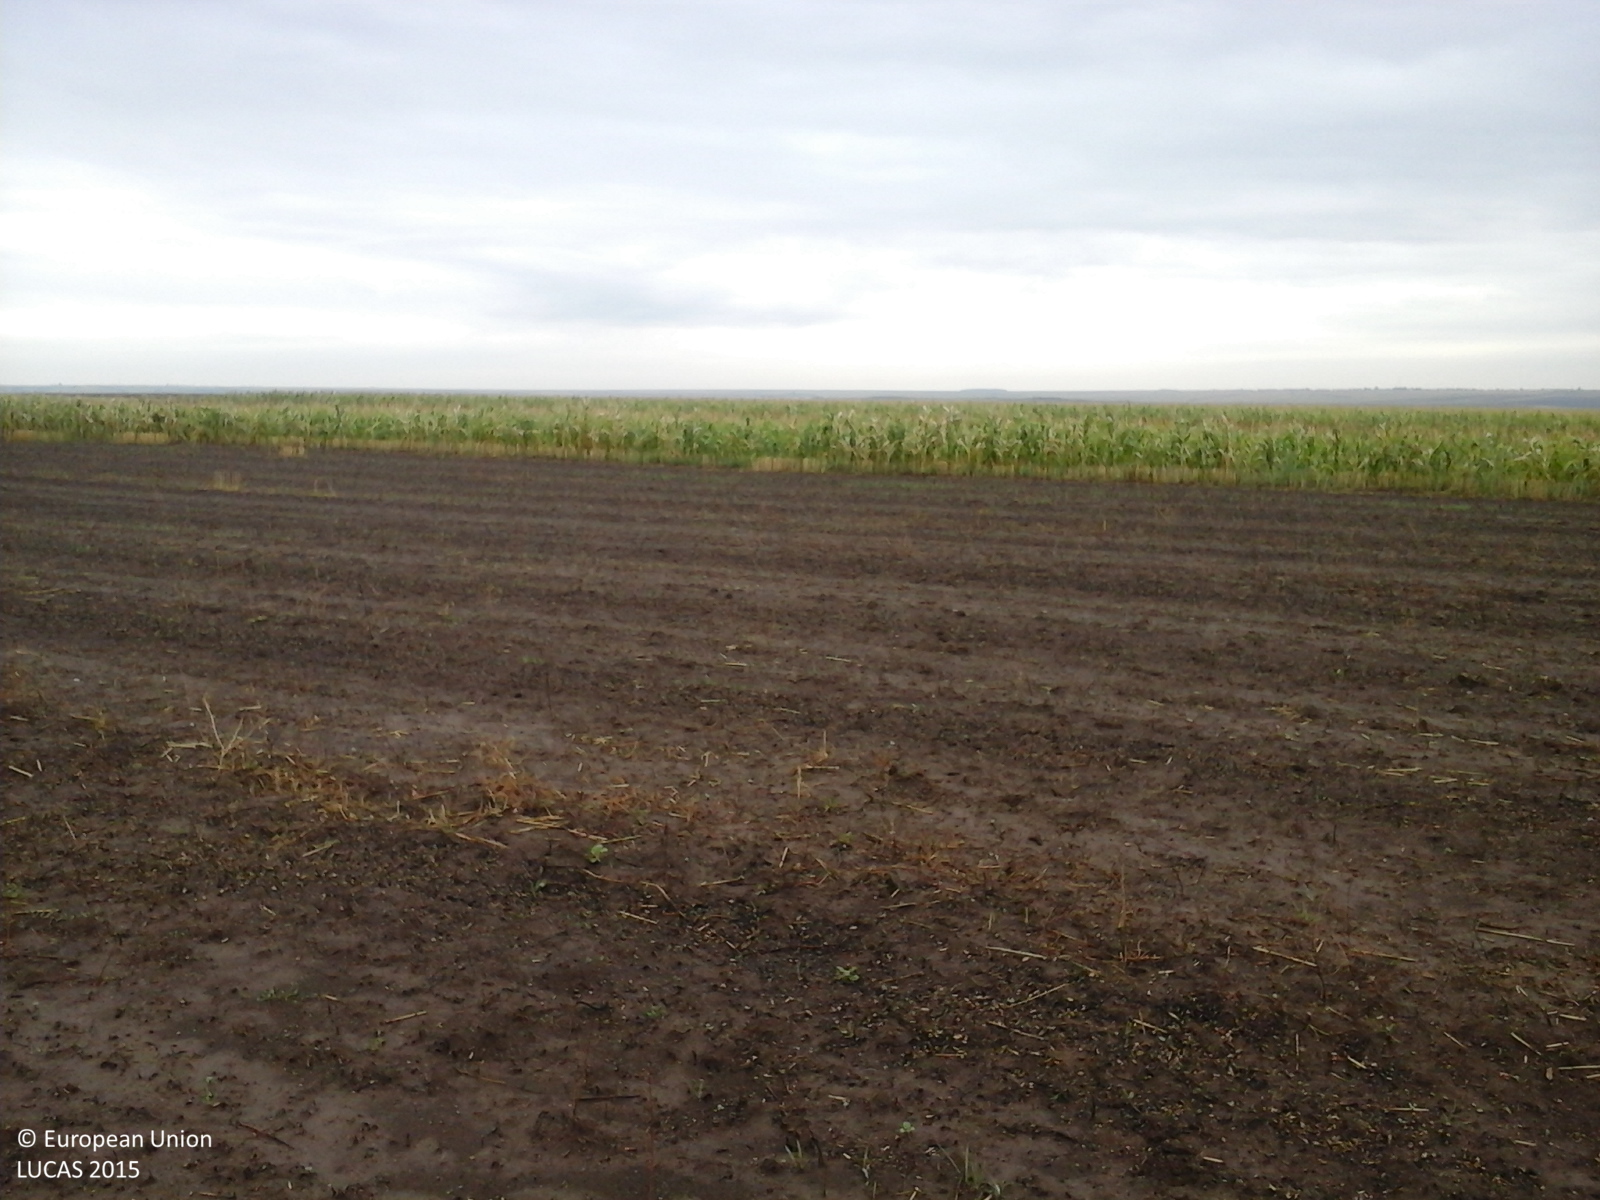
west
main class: Cropland
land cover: Common wheat
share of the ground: < 10 %
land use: Agriculture (excluding fallow land and kitchen gardens)
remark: Burnt area
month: August
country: RO
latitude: 45.9905
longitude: 21.4340
